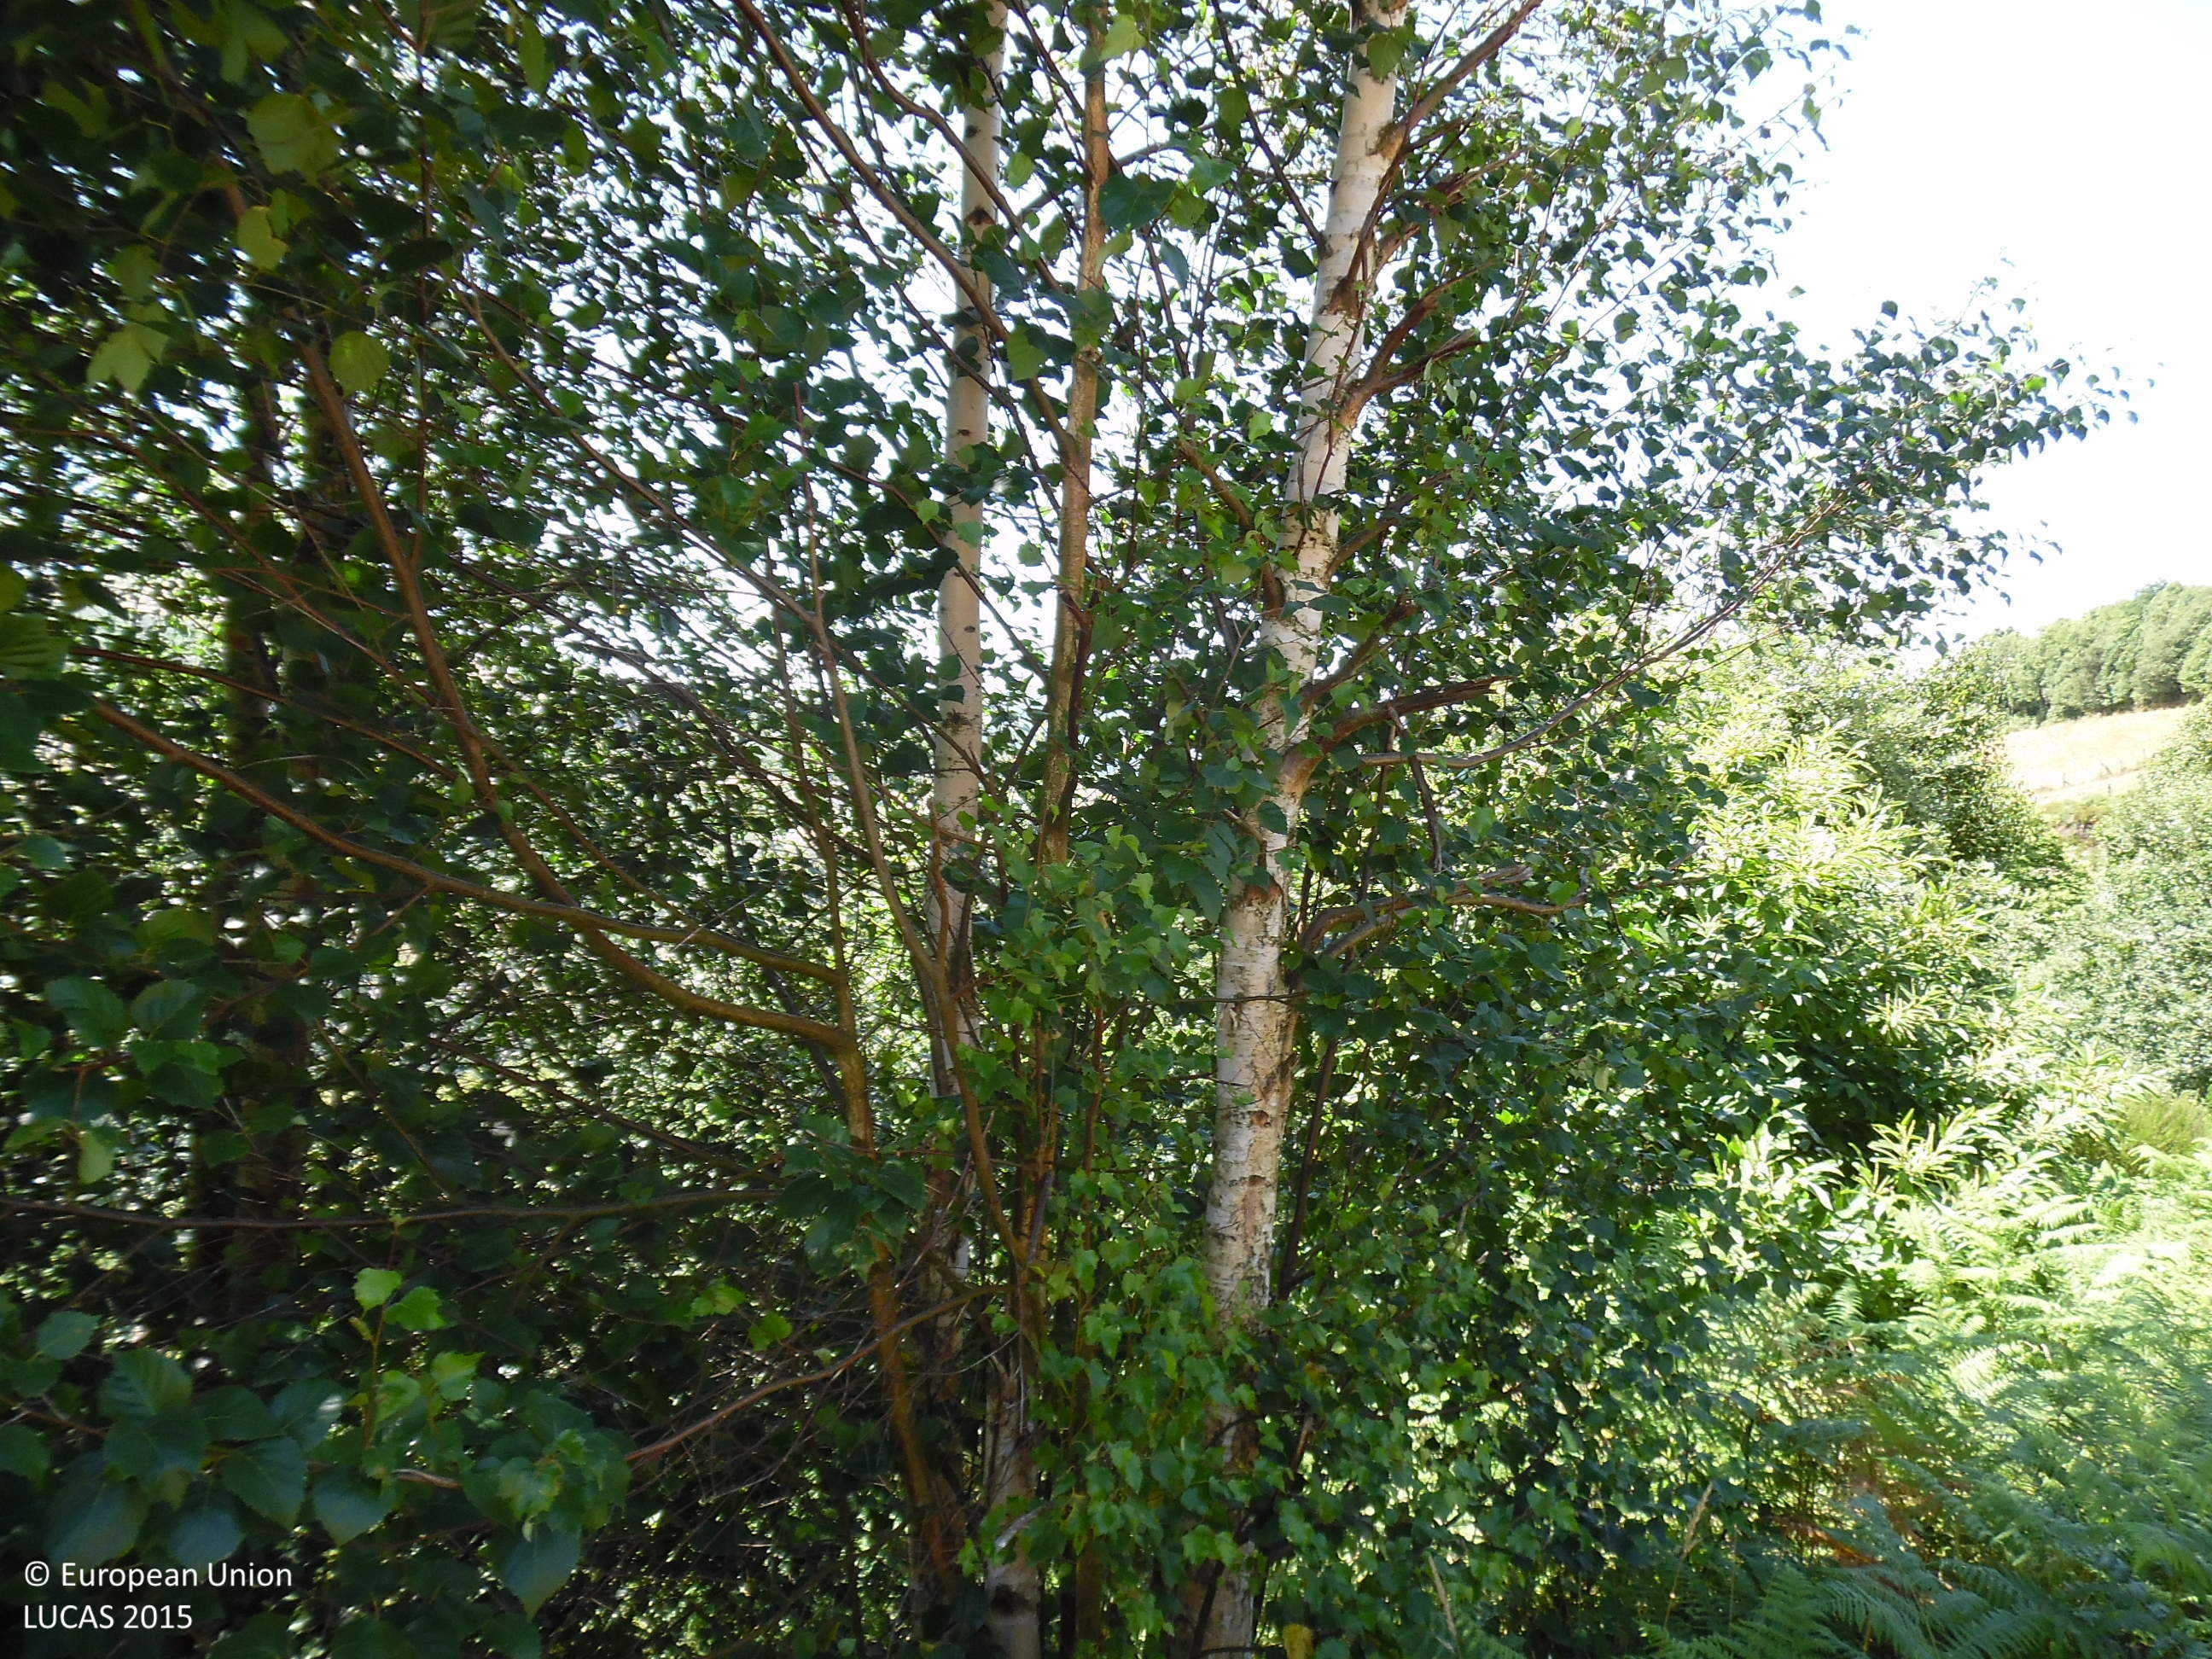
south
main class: Shrubland
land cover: Shrubland with sparse tree cover
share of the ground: 50 - 75 %
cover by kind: shrubs 80 %, consolidated bare surface 15 %, broadleaved forest trees 5 %
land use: Forestry
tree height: < 5 m
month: July
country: ES
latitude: 43.2031
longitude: -6.6079
